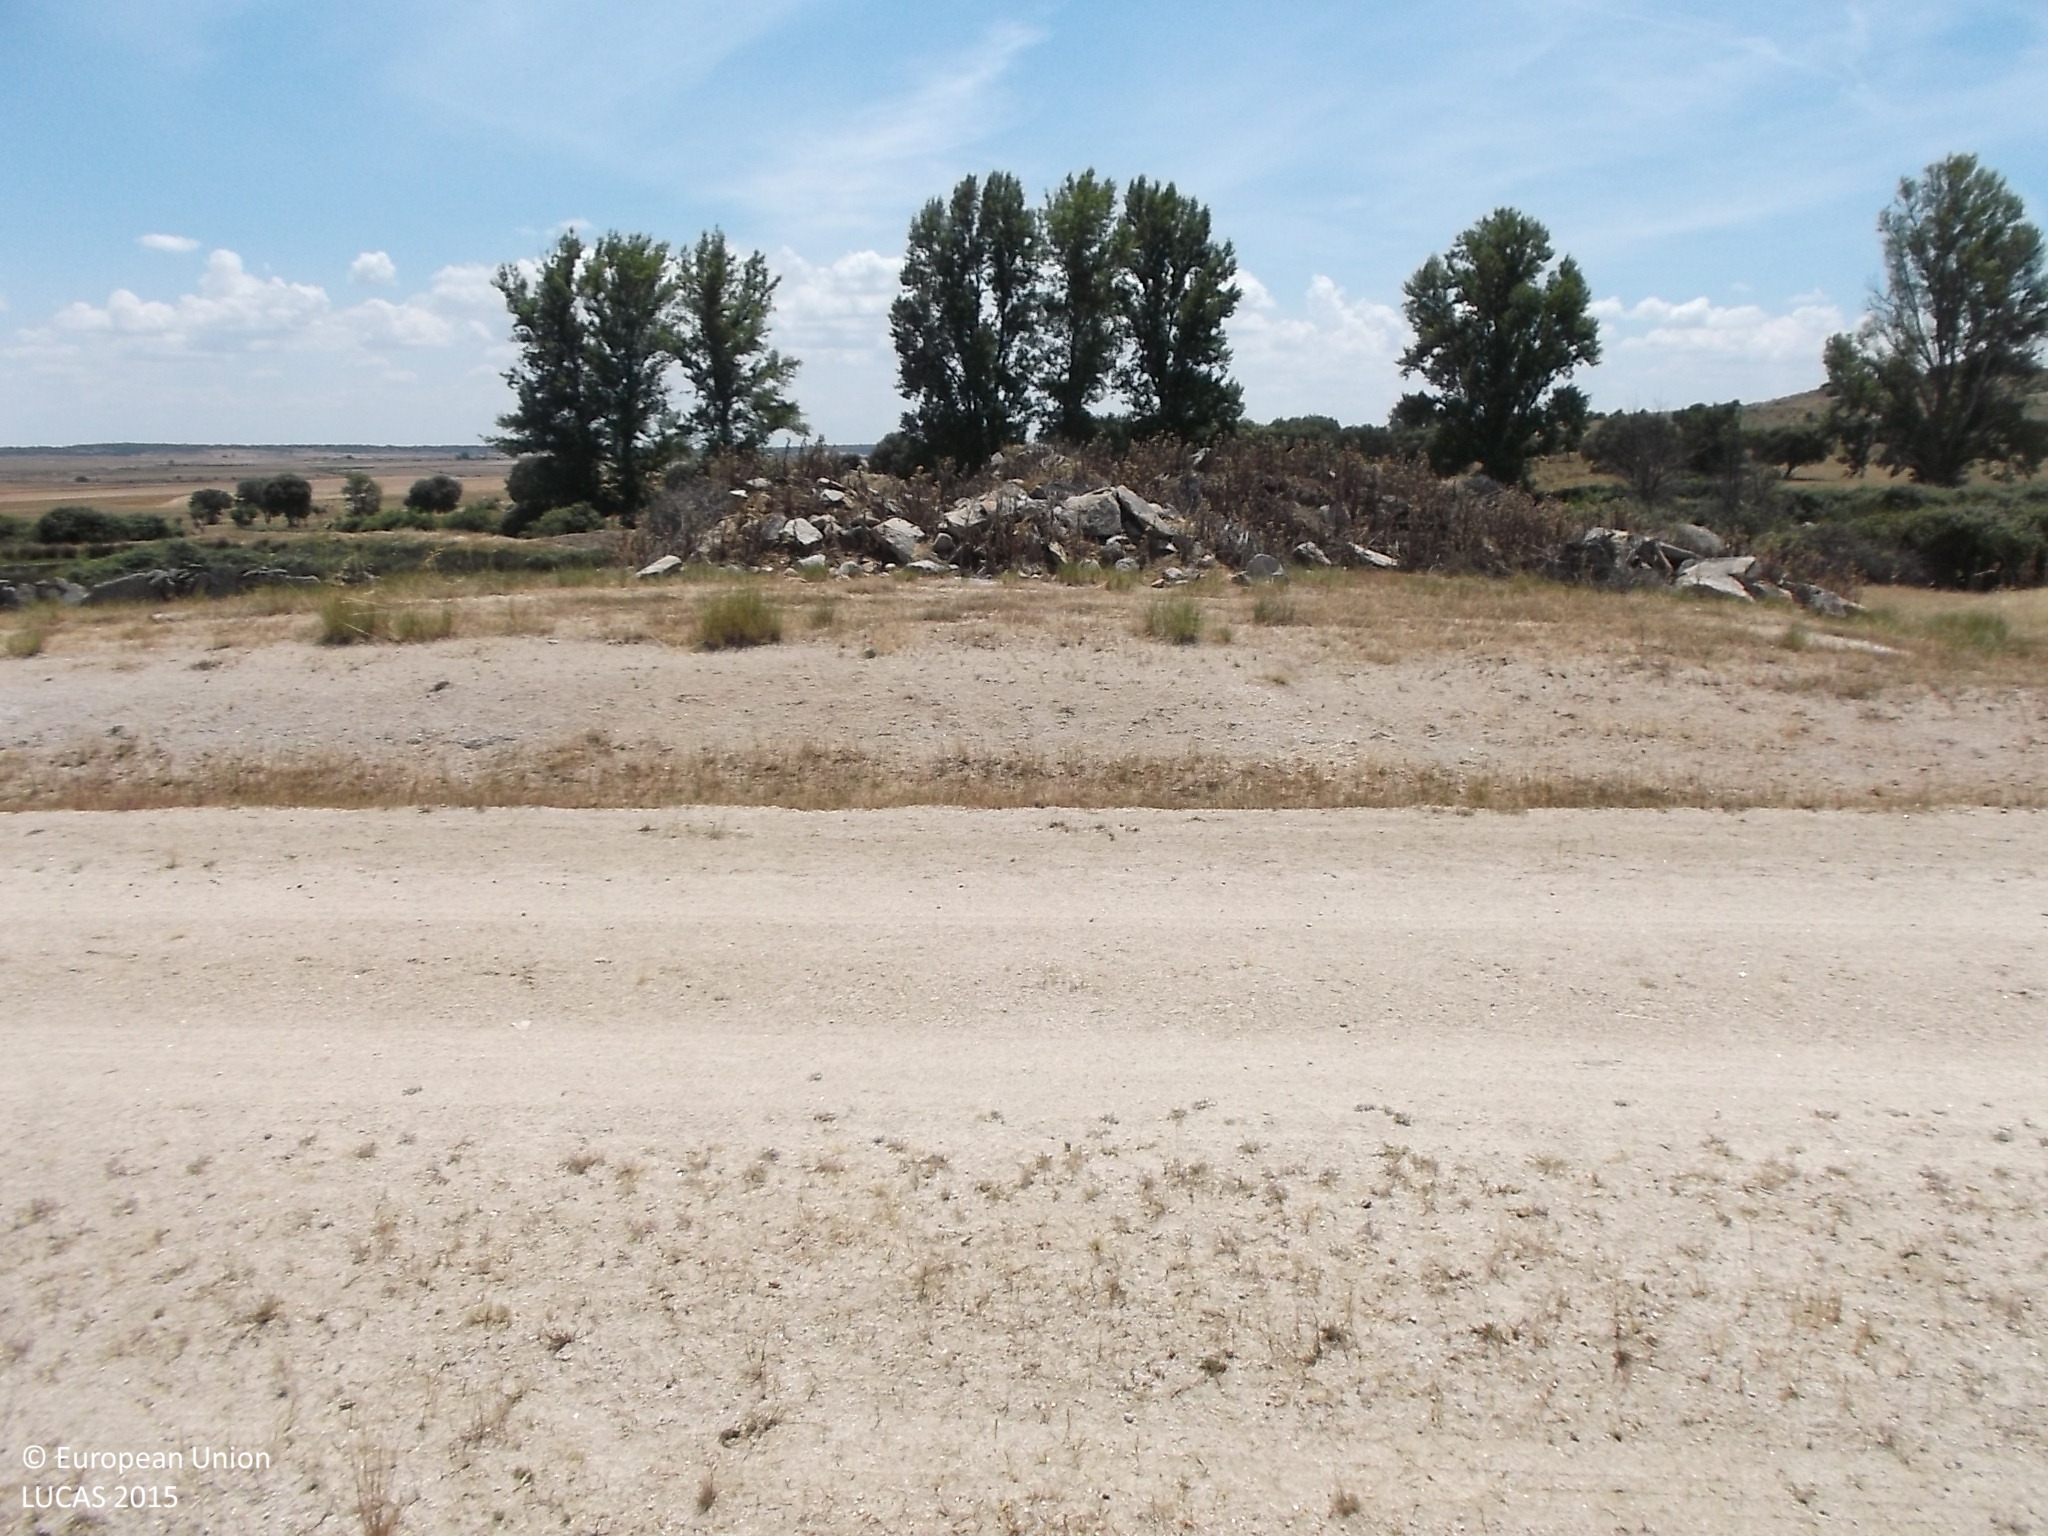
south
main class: Cropland
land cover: Oats
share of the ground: > 75 %
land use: Agriculture (excluding fallow land and kitchen gardens)
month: June
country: ES
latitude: 41.2900
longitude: -6.0550
